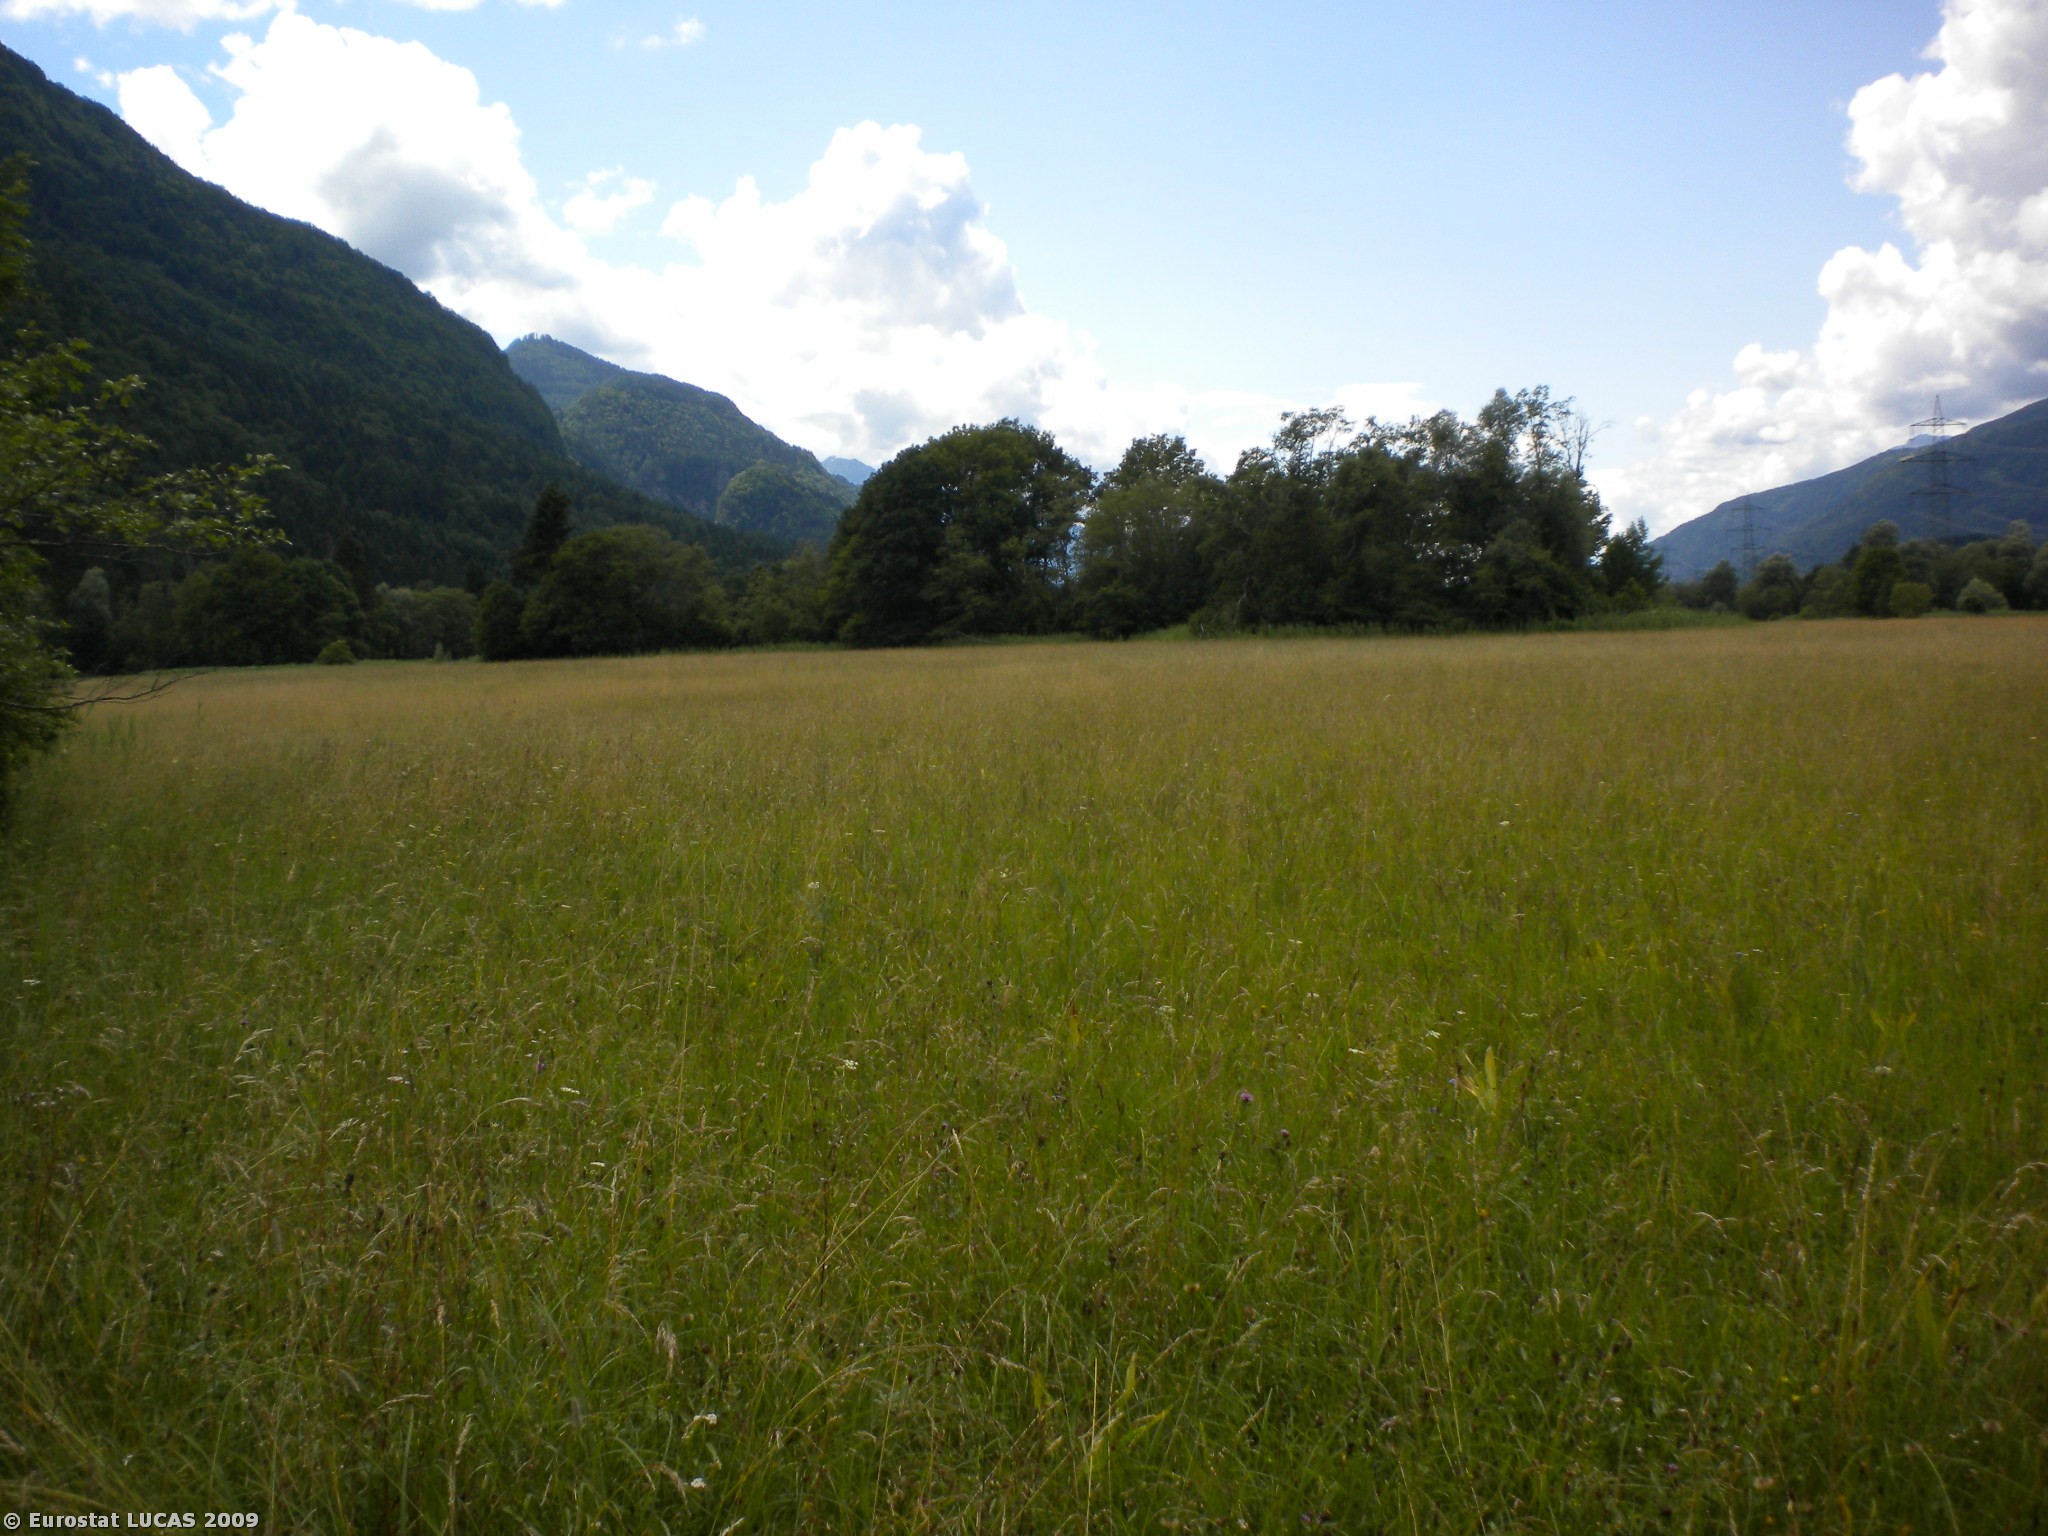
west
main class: Grassland
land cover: Grassland without tree/shrub cover
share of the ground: > 75 %
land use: Agriculture (excluding fallow land and kitchen gardens)
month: July
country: AT
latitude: 46.6035
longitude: 13.4045
